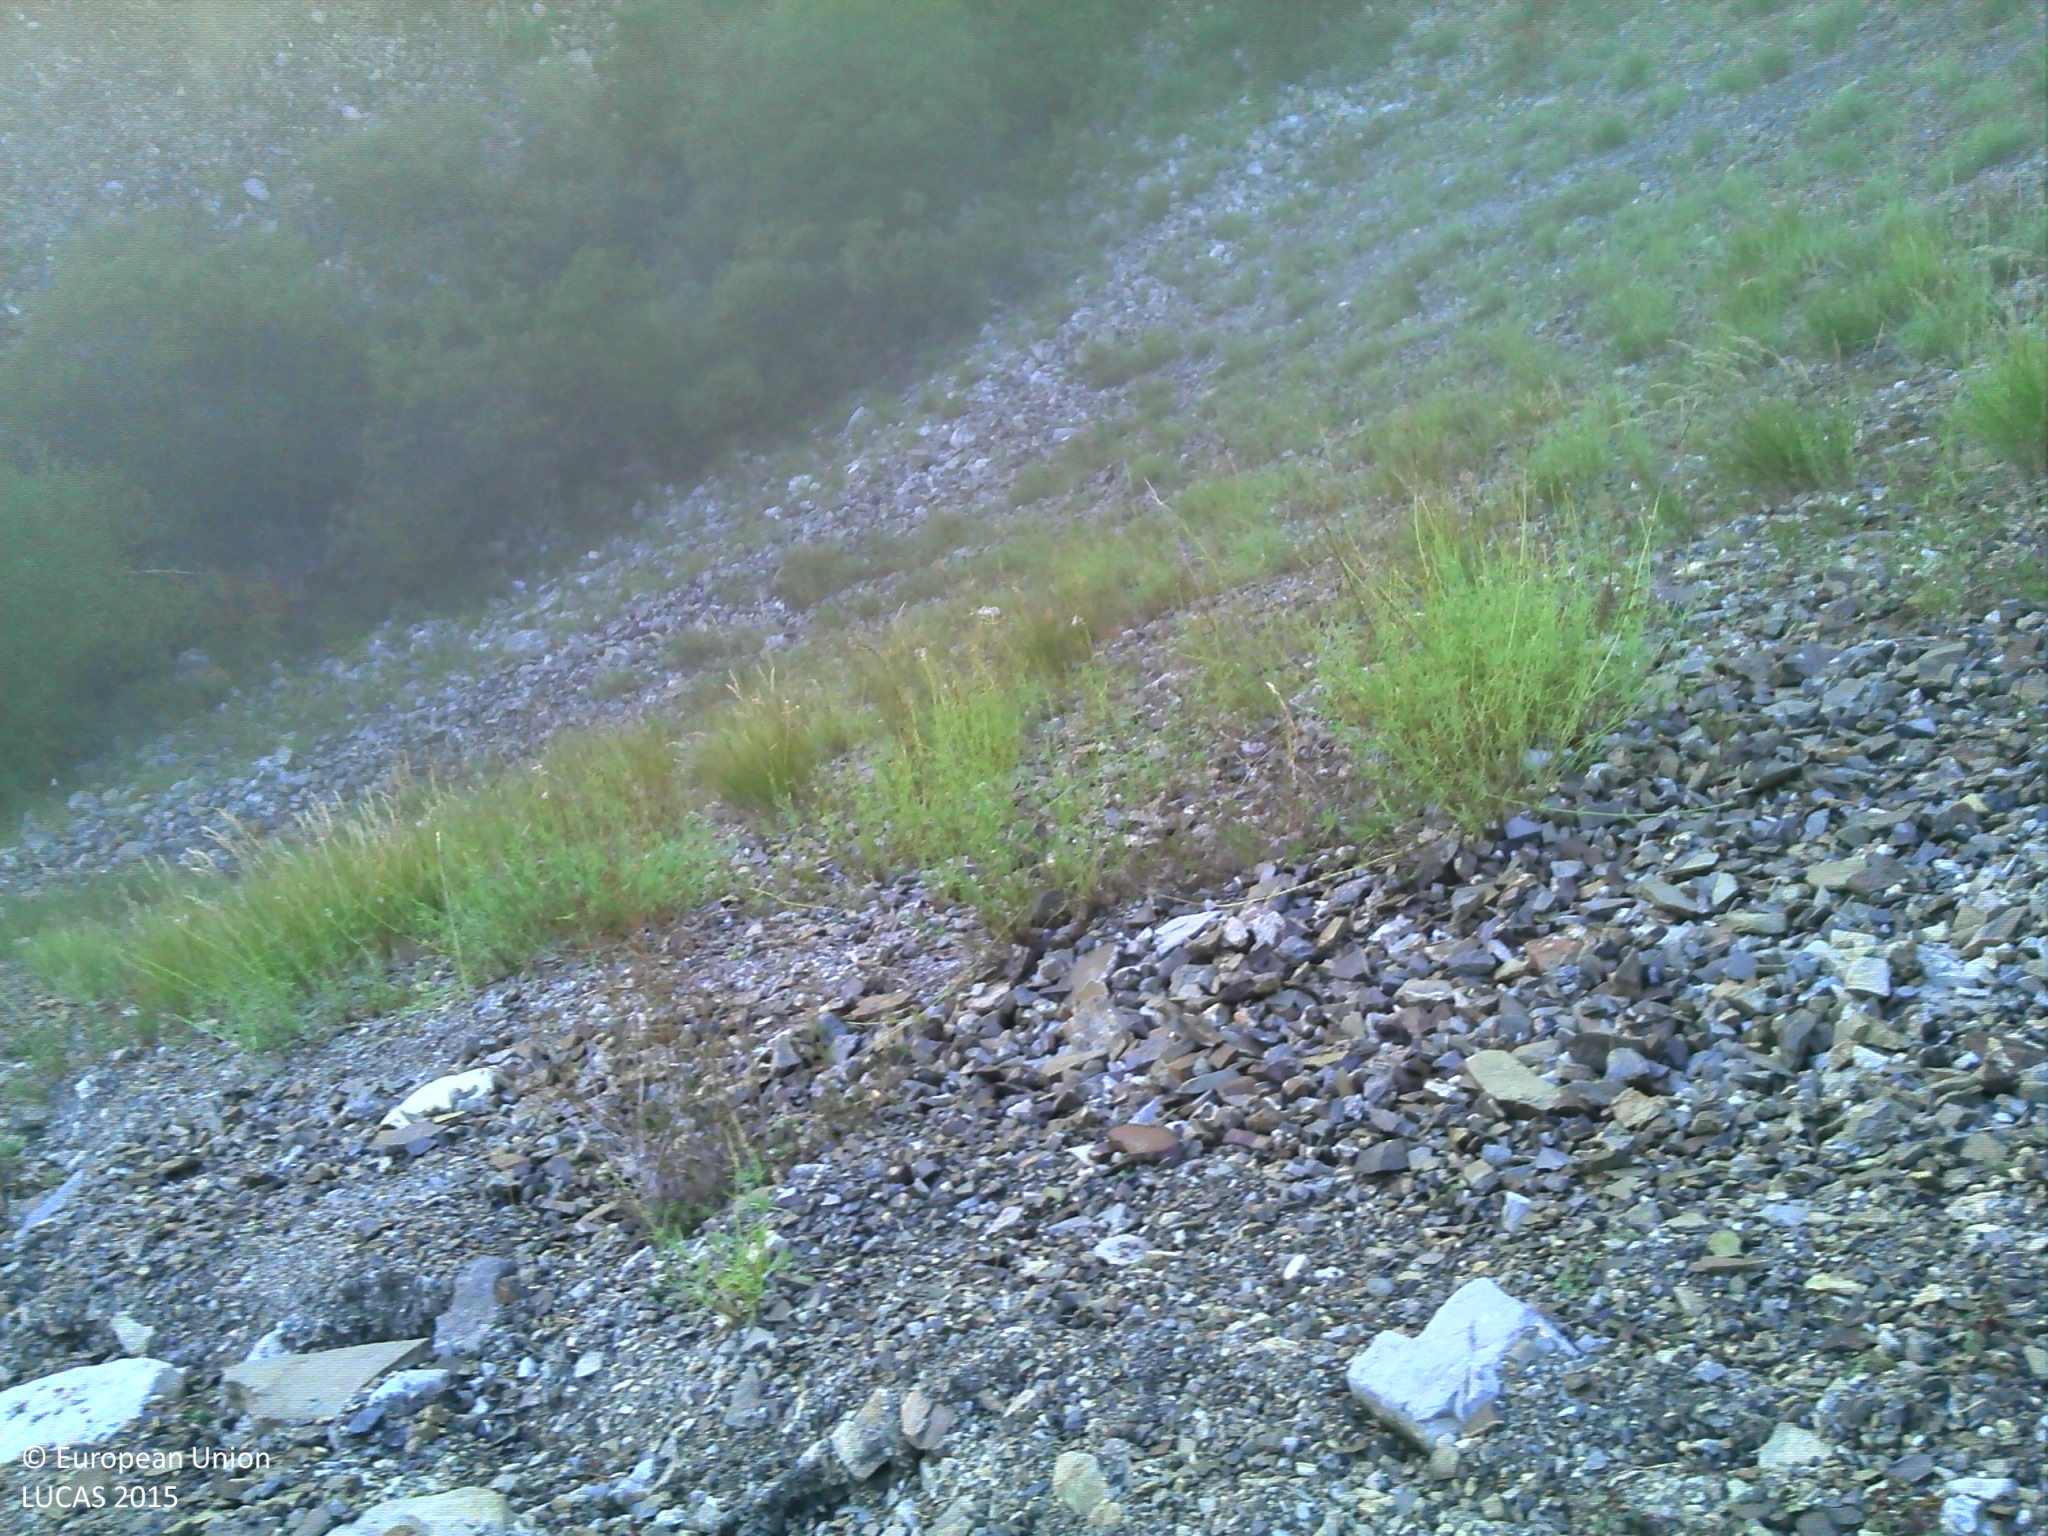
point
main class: Grassland
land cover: Spontaneously vegetated surfaces
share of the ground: 25 - 50 %
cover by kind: consolidated bare surface 60 %, herbaceous plants 40 %
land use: Semi-natural and natural areas not in use
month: September
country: FR
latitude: 44.6254
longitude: 6.2378
